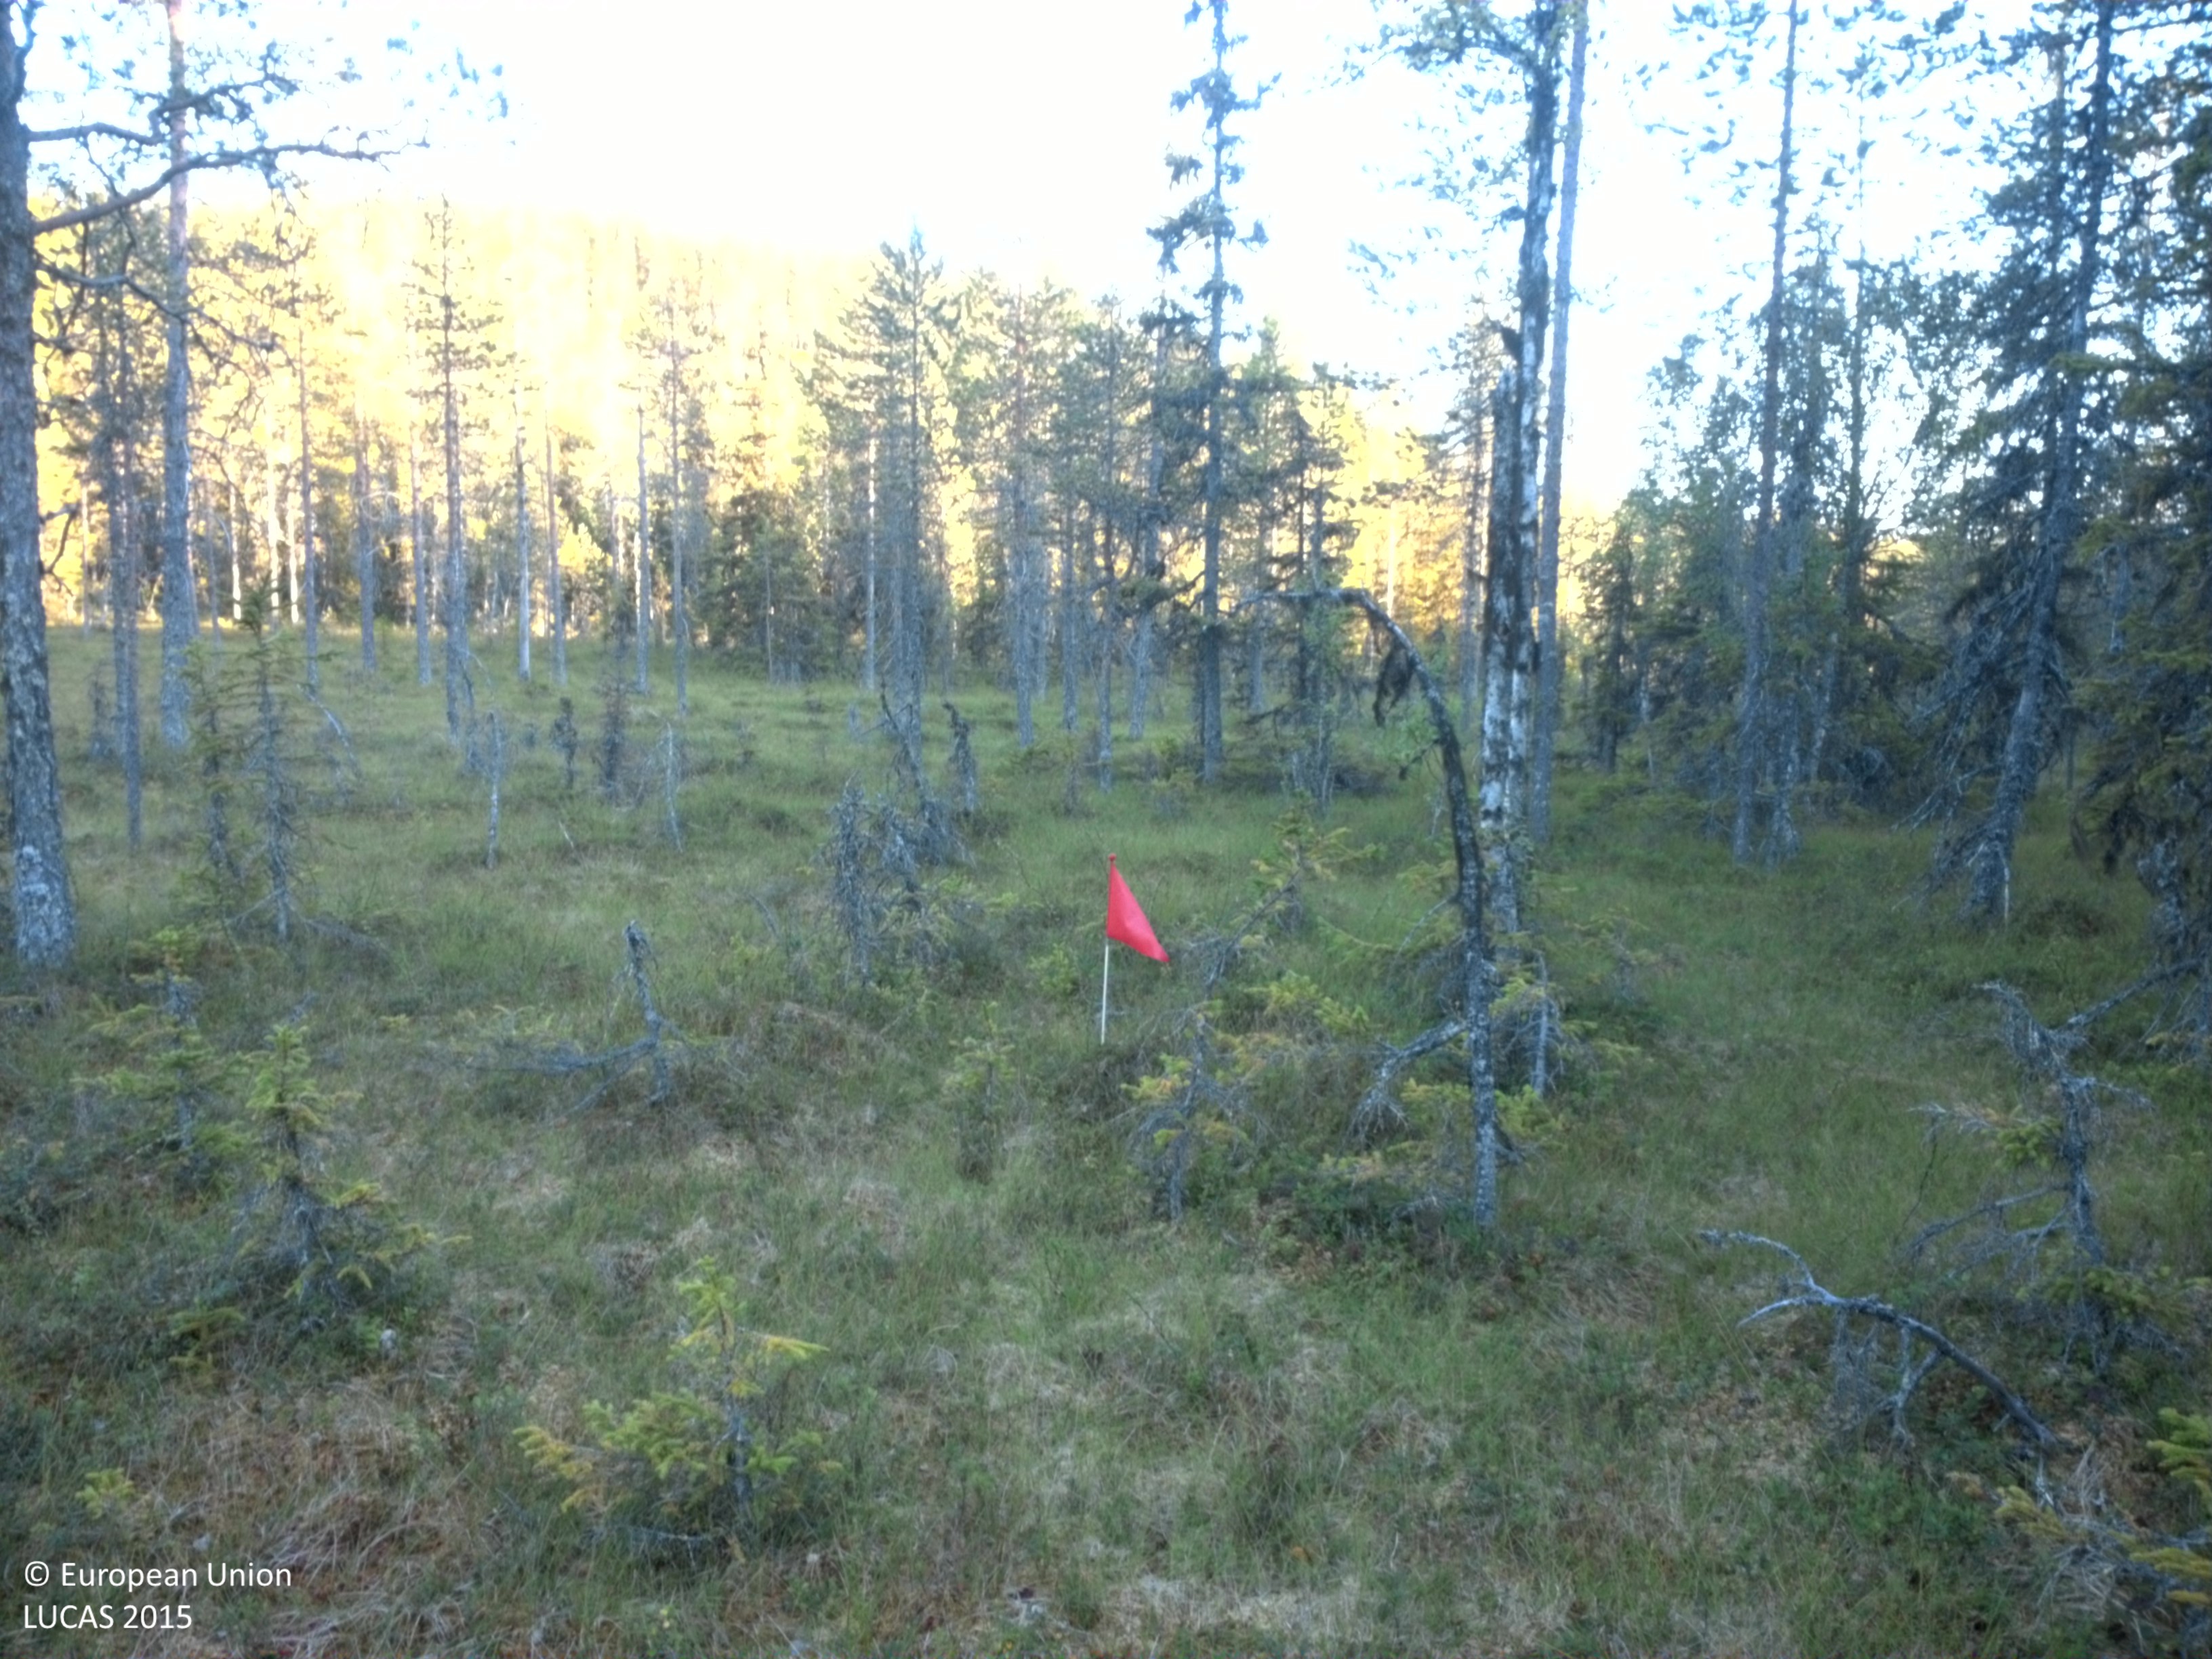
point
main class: Woodland
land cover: Pine dominated coniferous woodland
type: boreal forest
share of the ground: 25 - 50 %
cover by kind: coniferous forest trees 35 %, lichens and mosses 30 %, herbaceous plants 20 %, shrubs 15 %
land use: Forestry
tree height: > 5 m
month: August
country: SE
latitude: 64.4514
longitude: 18.6767
